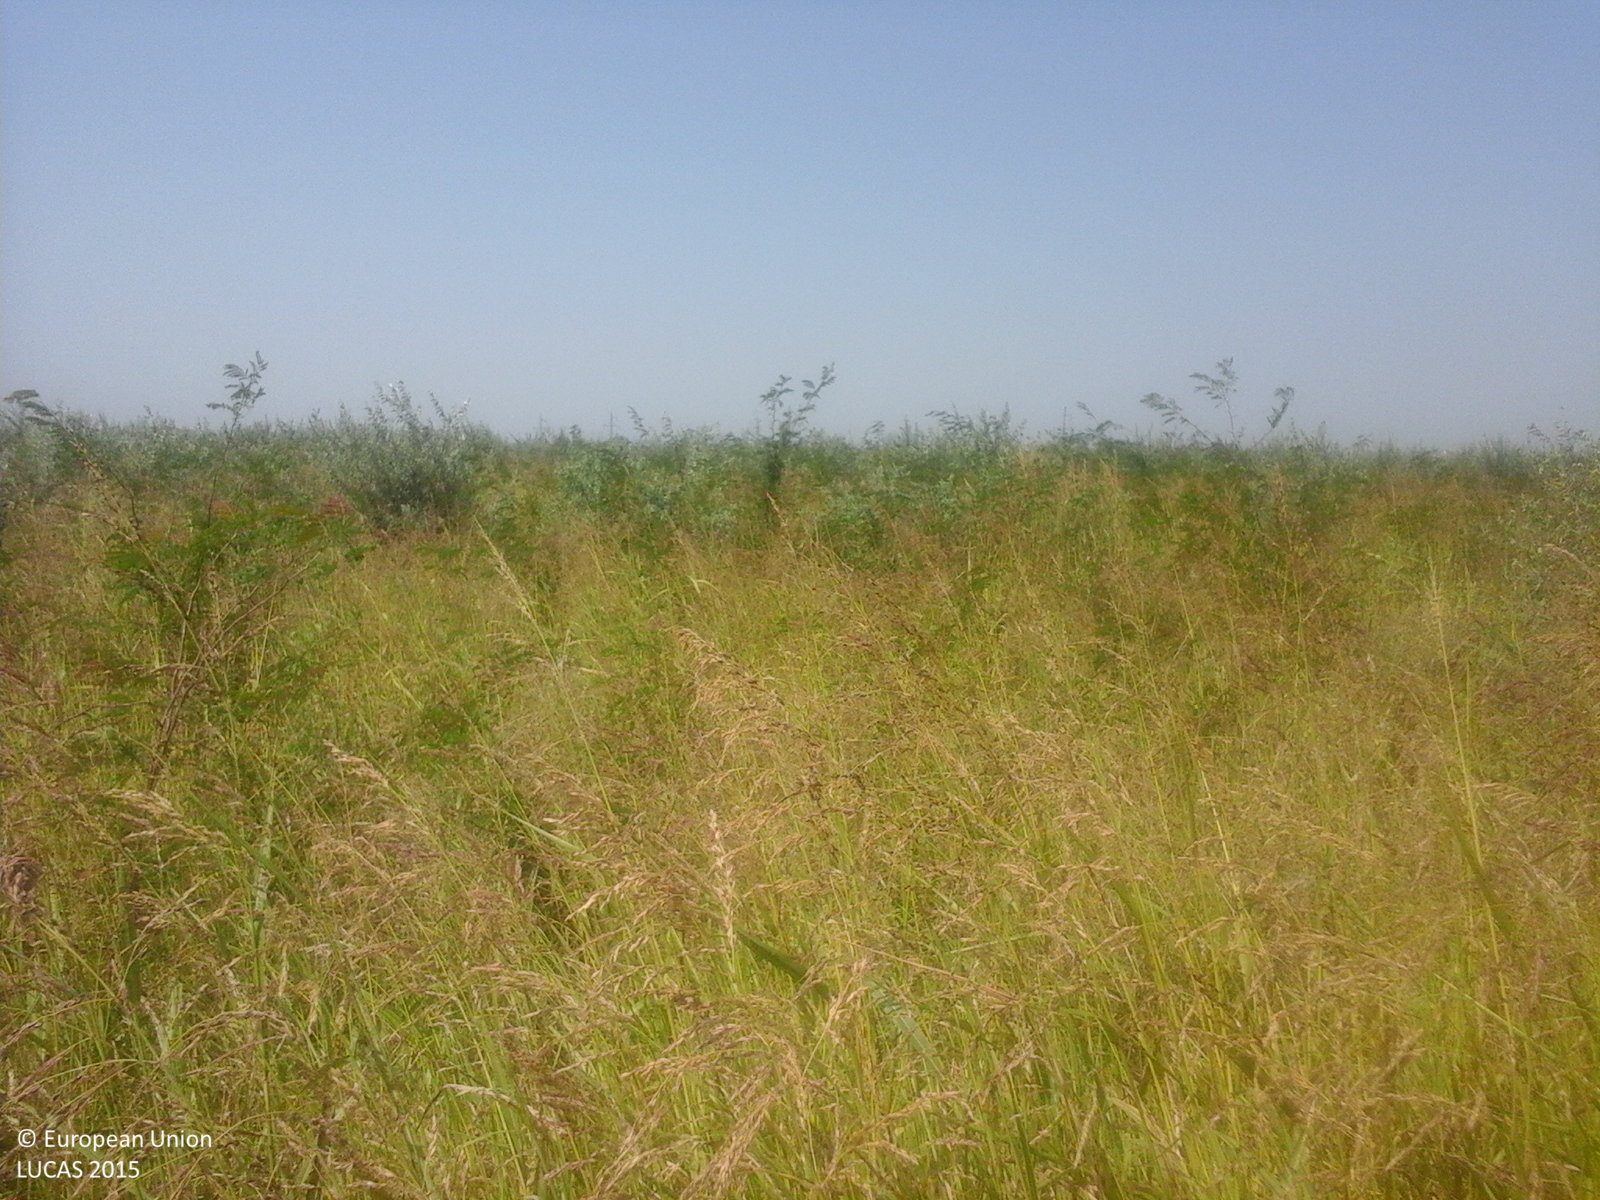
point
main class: Woodland
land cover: Broadleaved woodland
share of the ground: 10 - 25 %
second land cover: Spontaneously vegetated surfaces
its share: > 75 %
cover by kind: herbaceous plants 80 %, broadleaved forest trees 20 %
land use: Forestry
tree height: < 5 m
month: August
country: RO
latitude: 45.1334
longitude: 27.7162
